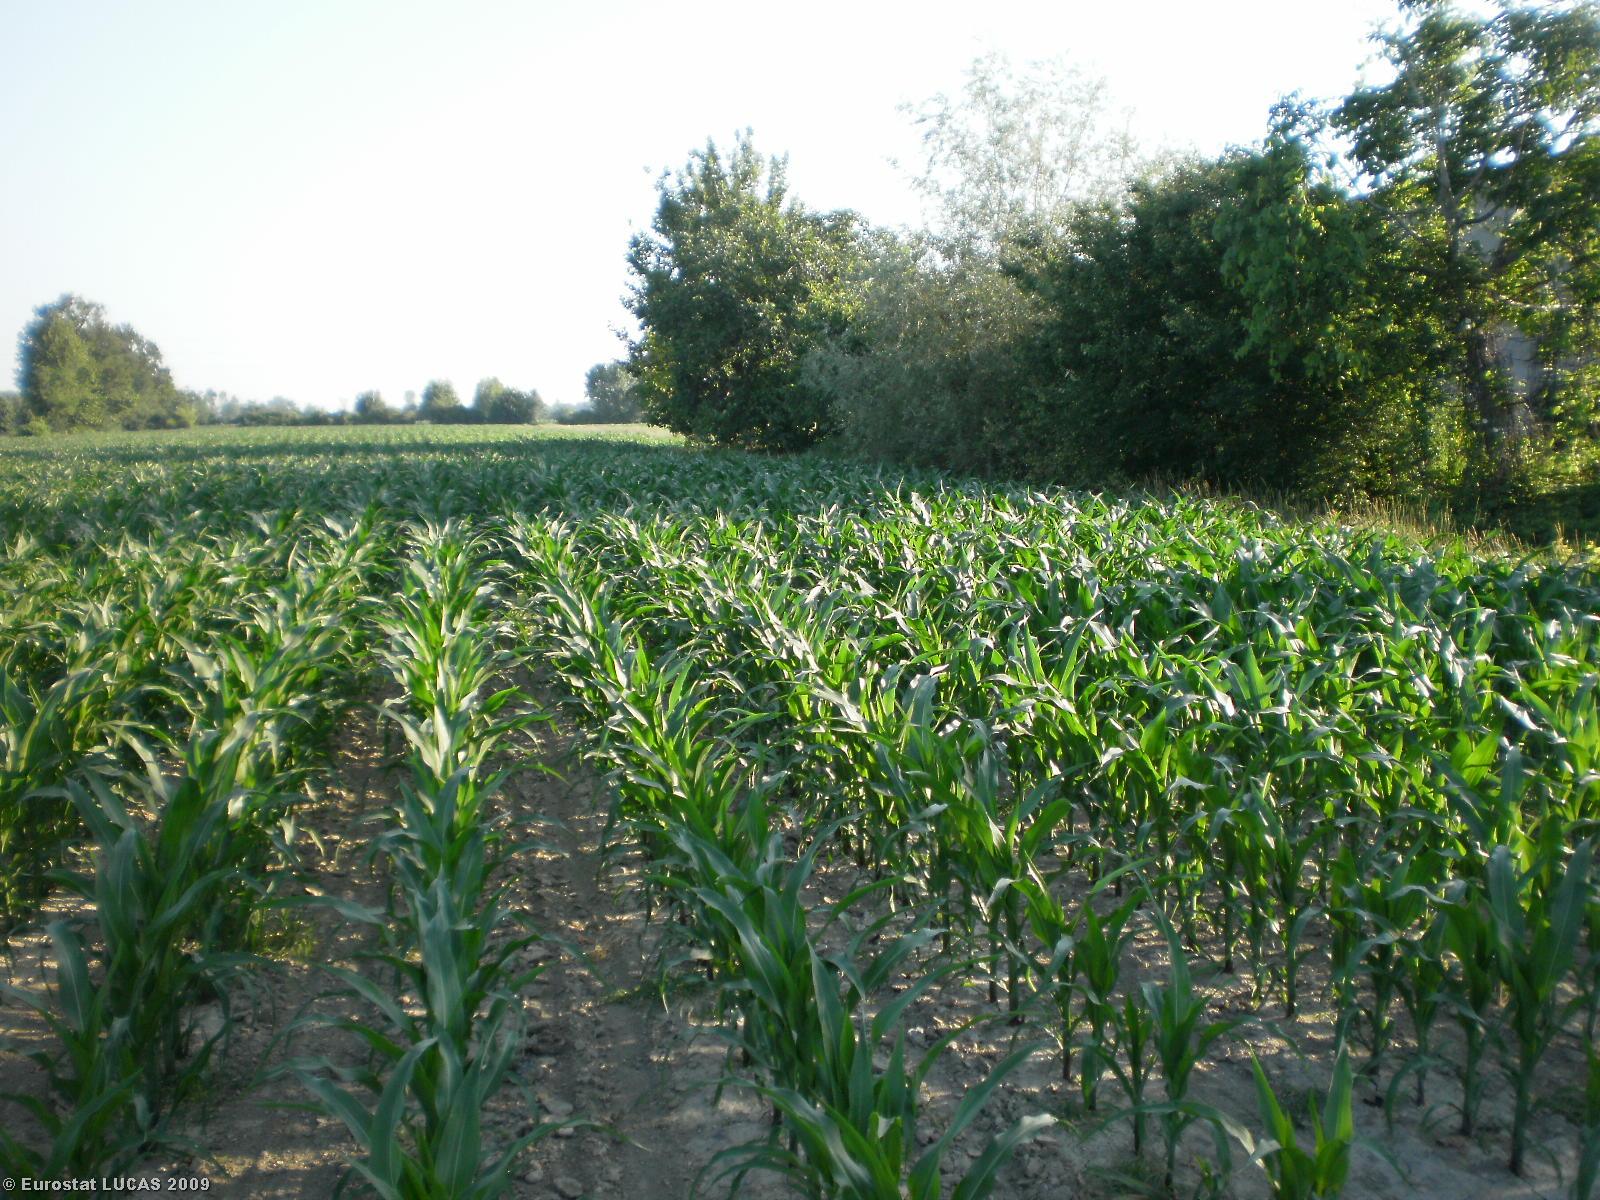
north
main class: Cropland
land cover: Maize
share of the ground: > 75 %
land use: Agriculture (excluding fallow land and kitchen gardens)
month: June
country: IT
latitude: 45.1796
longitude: 10.2667
